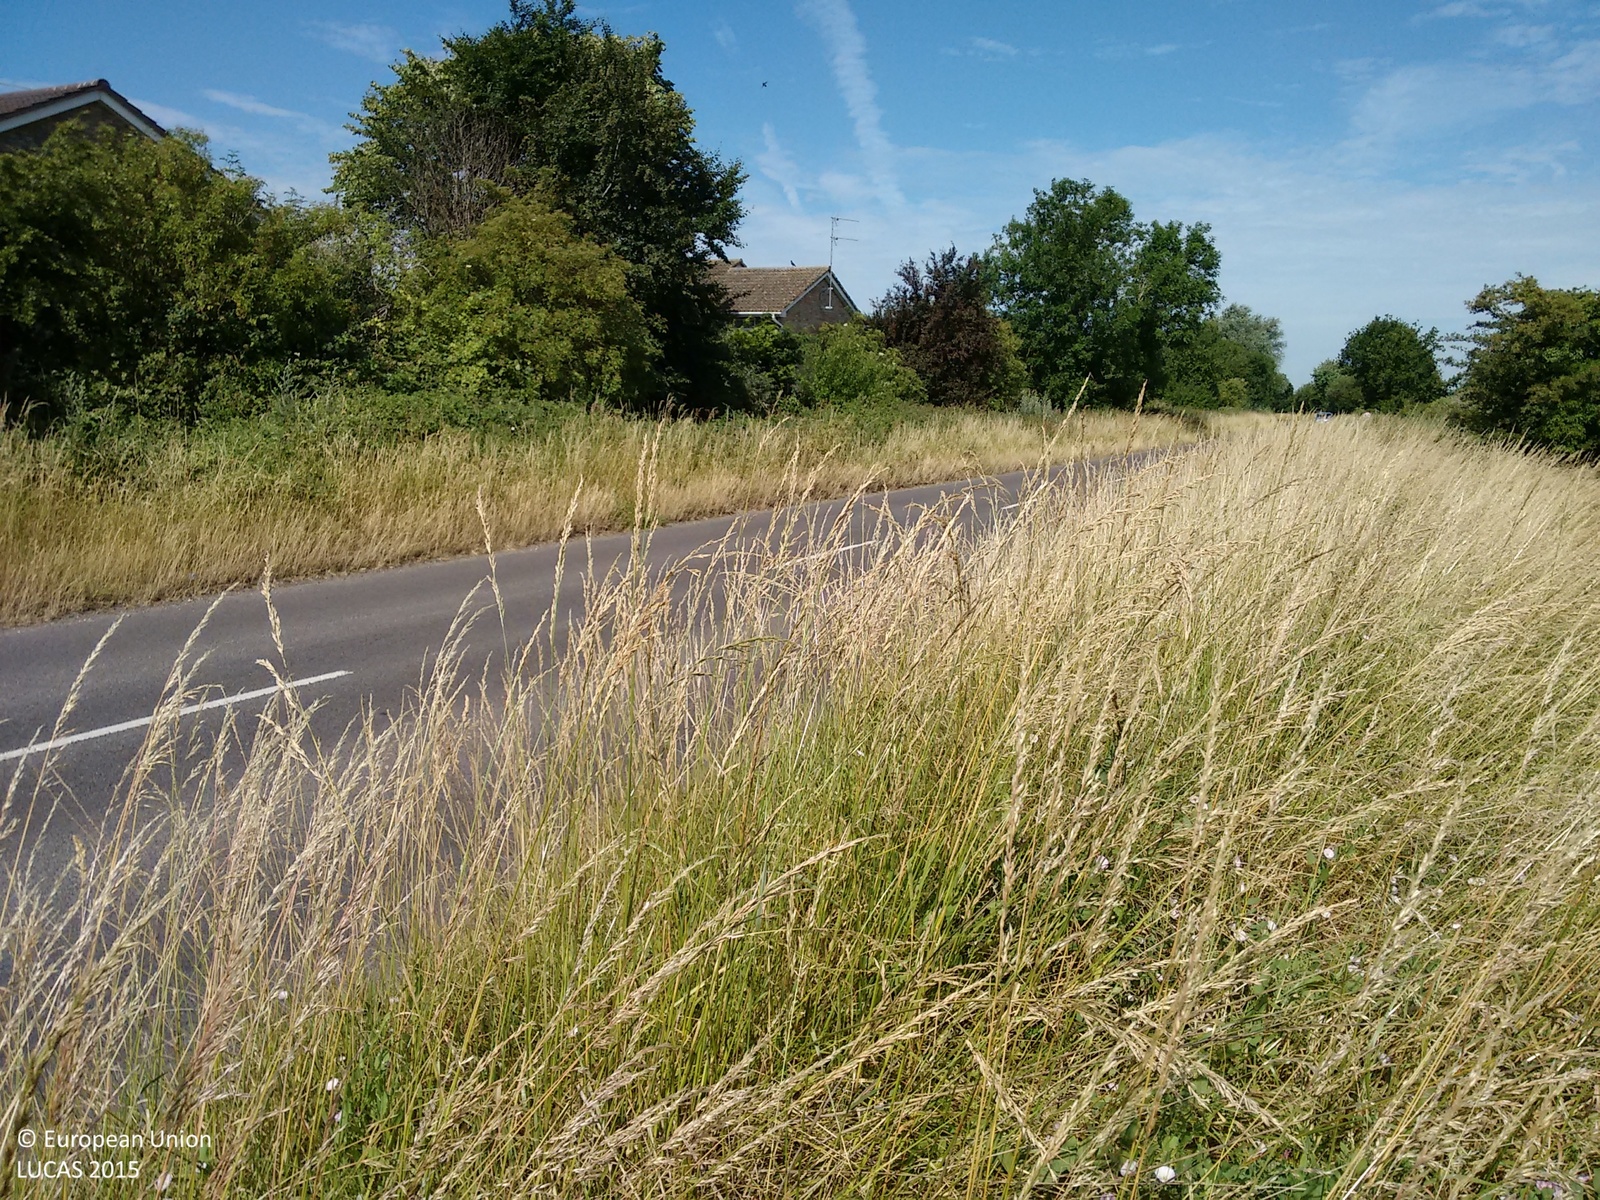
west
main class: Grassland
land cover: Grassland without tree/shrub cover
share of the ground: > 75 %
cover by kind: herbaceous plants 100 %
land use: Air transport
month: July
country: GB
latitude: 51.6755
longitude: -1.0794
